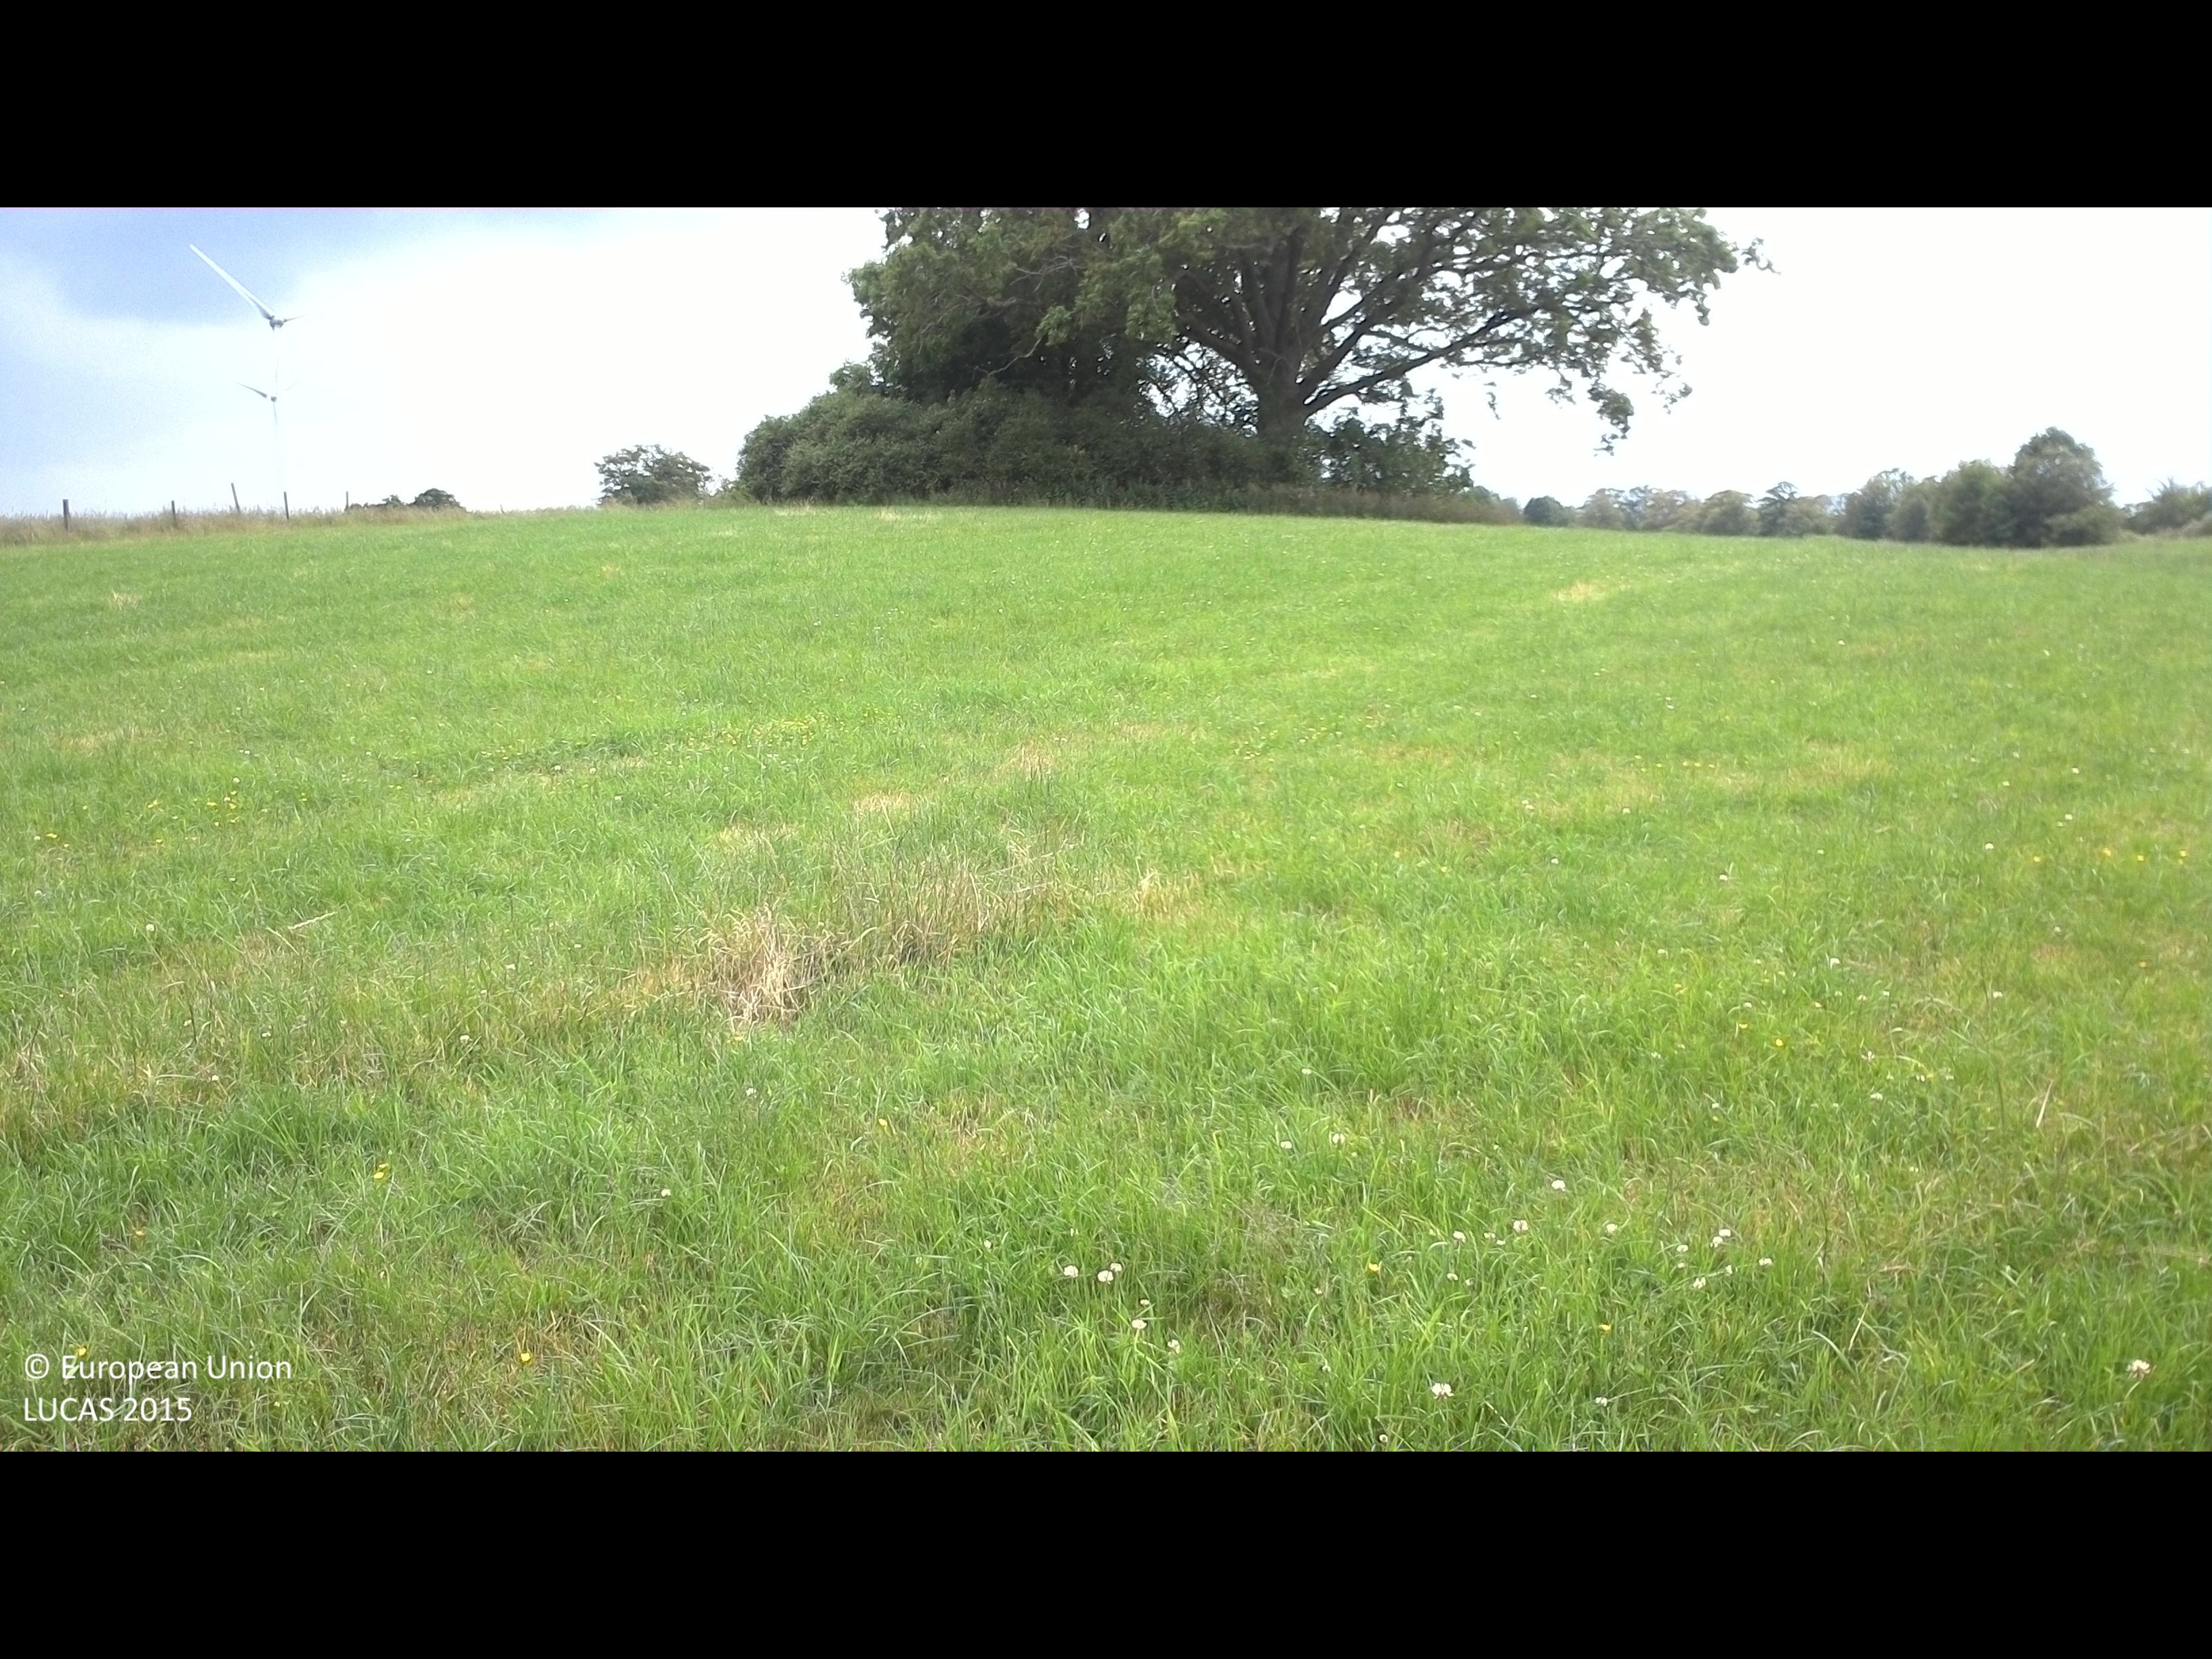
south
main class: Cropland
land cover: Temporary grasslands
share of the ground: > 75 %
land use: Agriculture (excluding fallow land and kitchen gardens)
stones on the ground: < 10 %
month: June
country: SE
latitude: 56.4403
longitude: 16.0830
